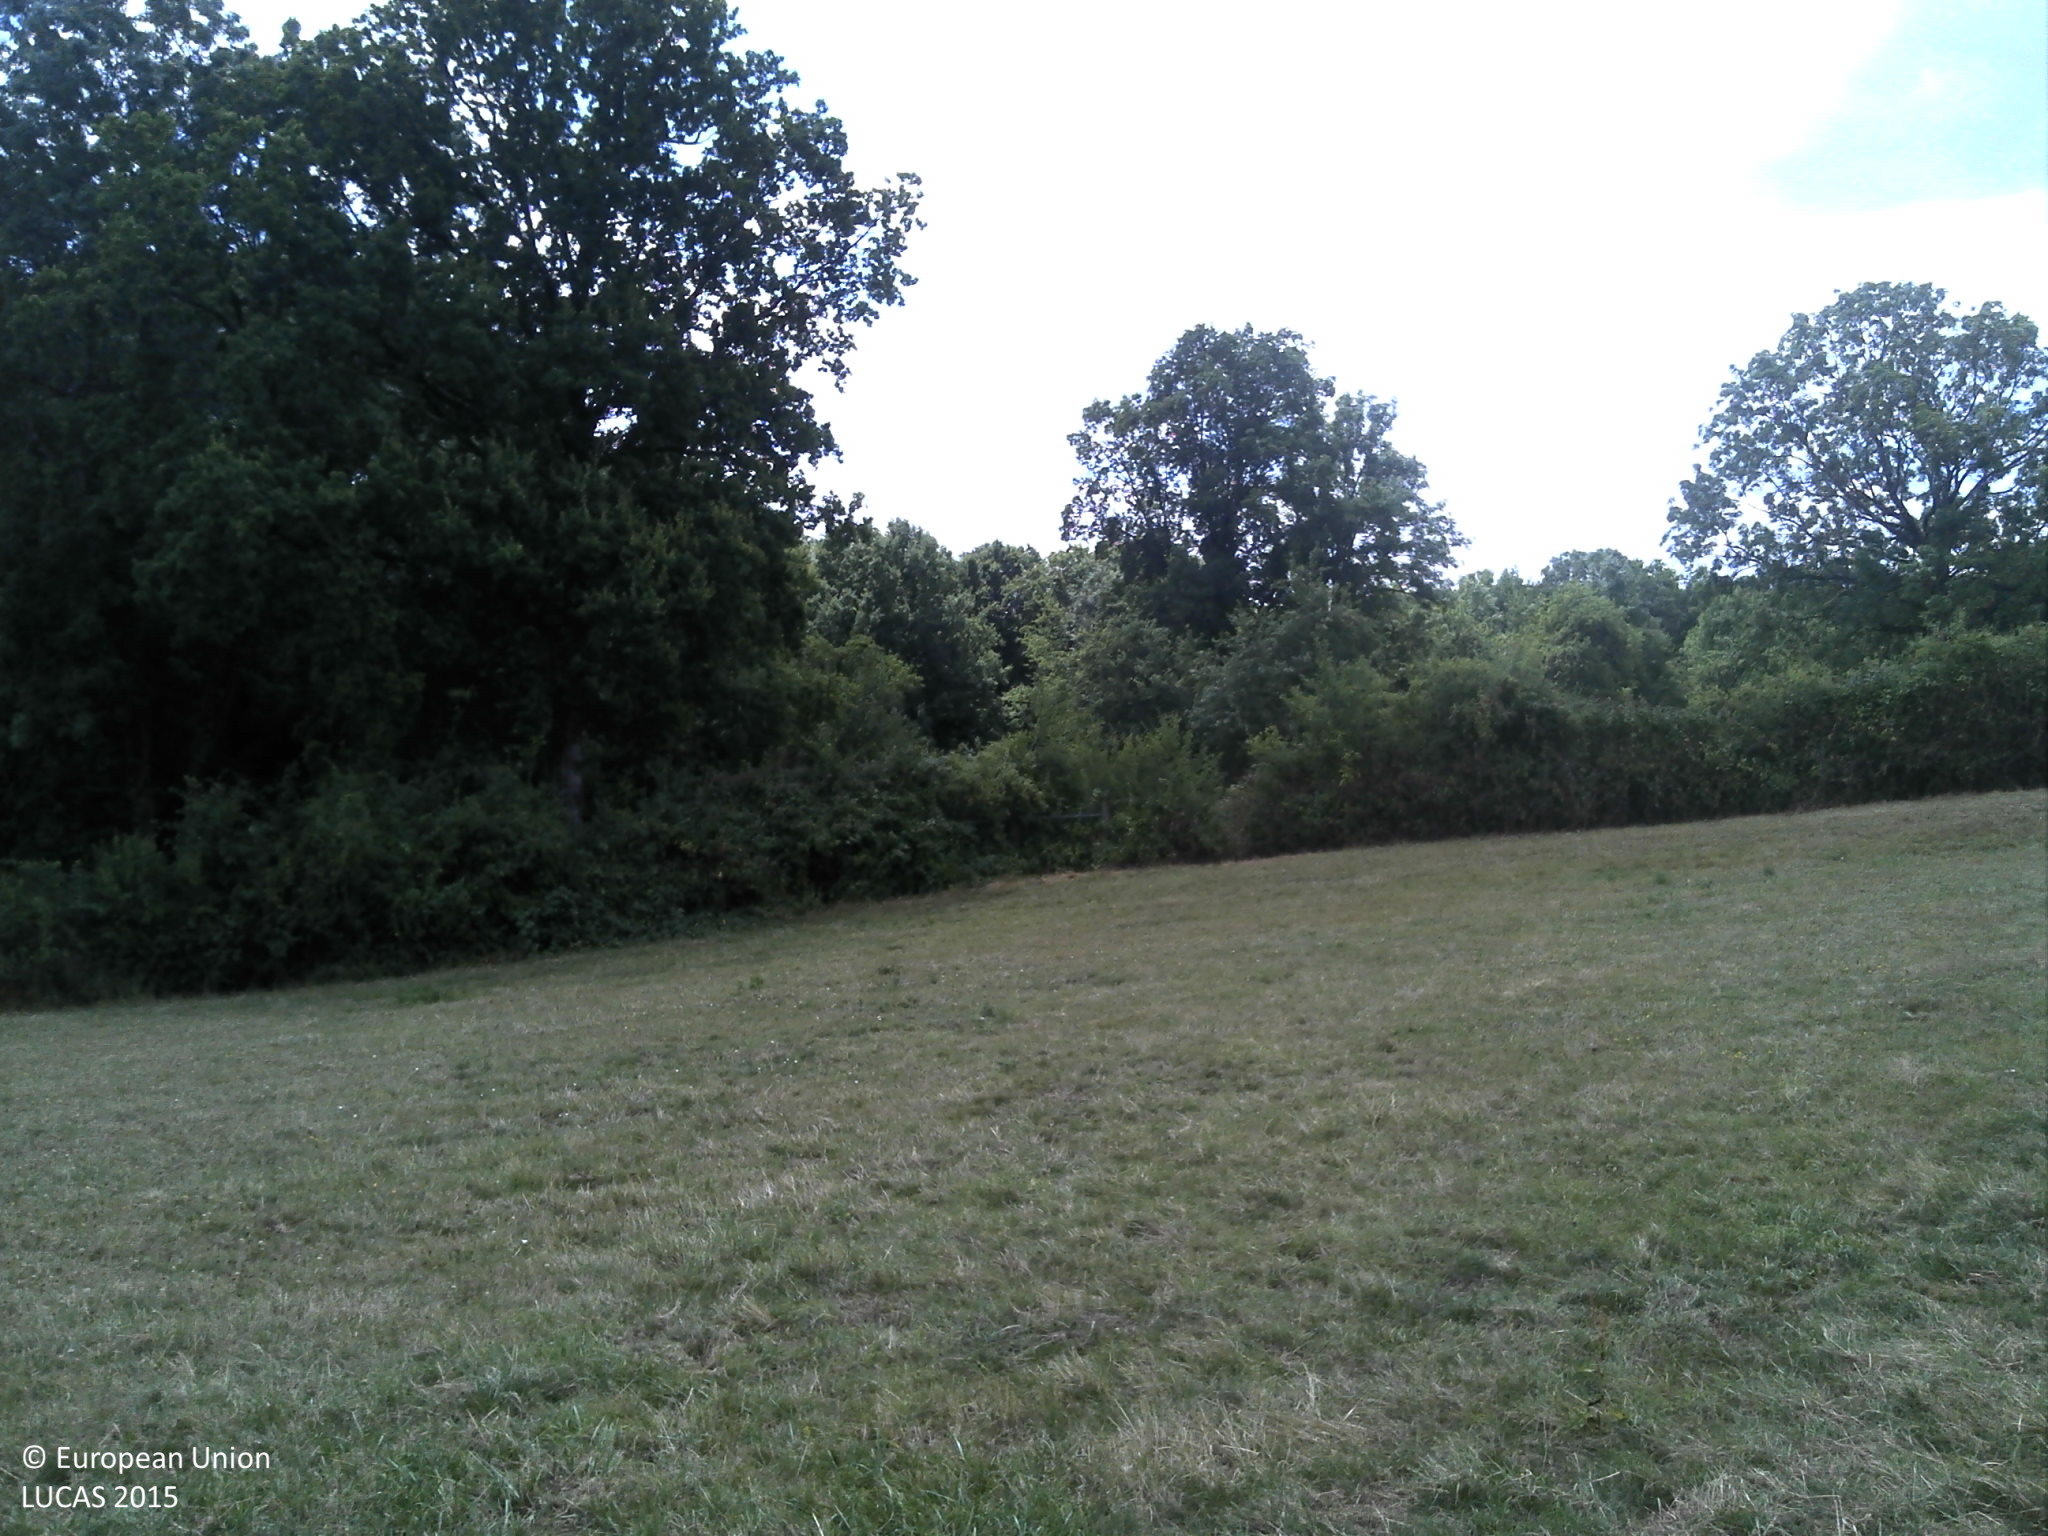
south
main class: Grassland
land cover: Grassland with sparse tree/shrub cover
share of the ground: > 75 %
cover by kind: herbaceous plants 95 %, broadleaved forest trees 5 %
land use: Agriculture (excluding fallow land and kitchen gardens)
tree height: > 5 m
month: July
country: FR
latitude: 49.6176
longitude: 4.4734
